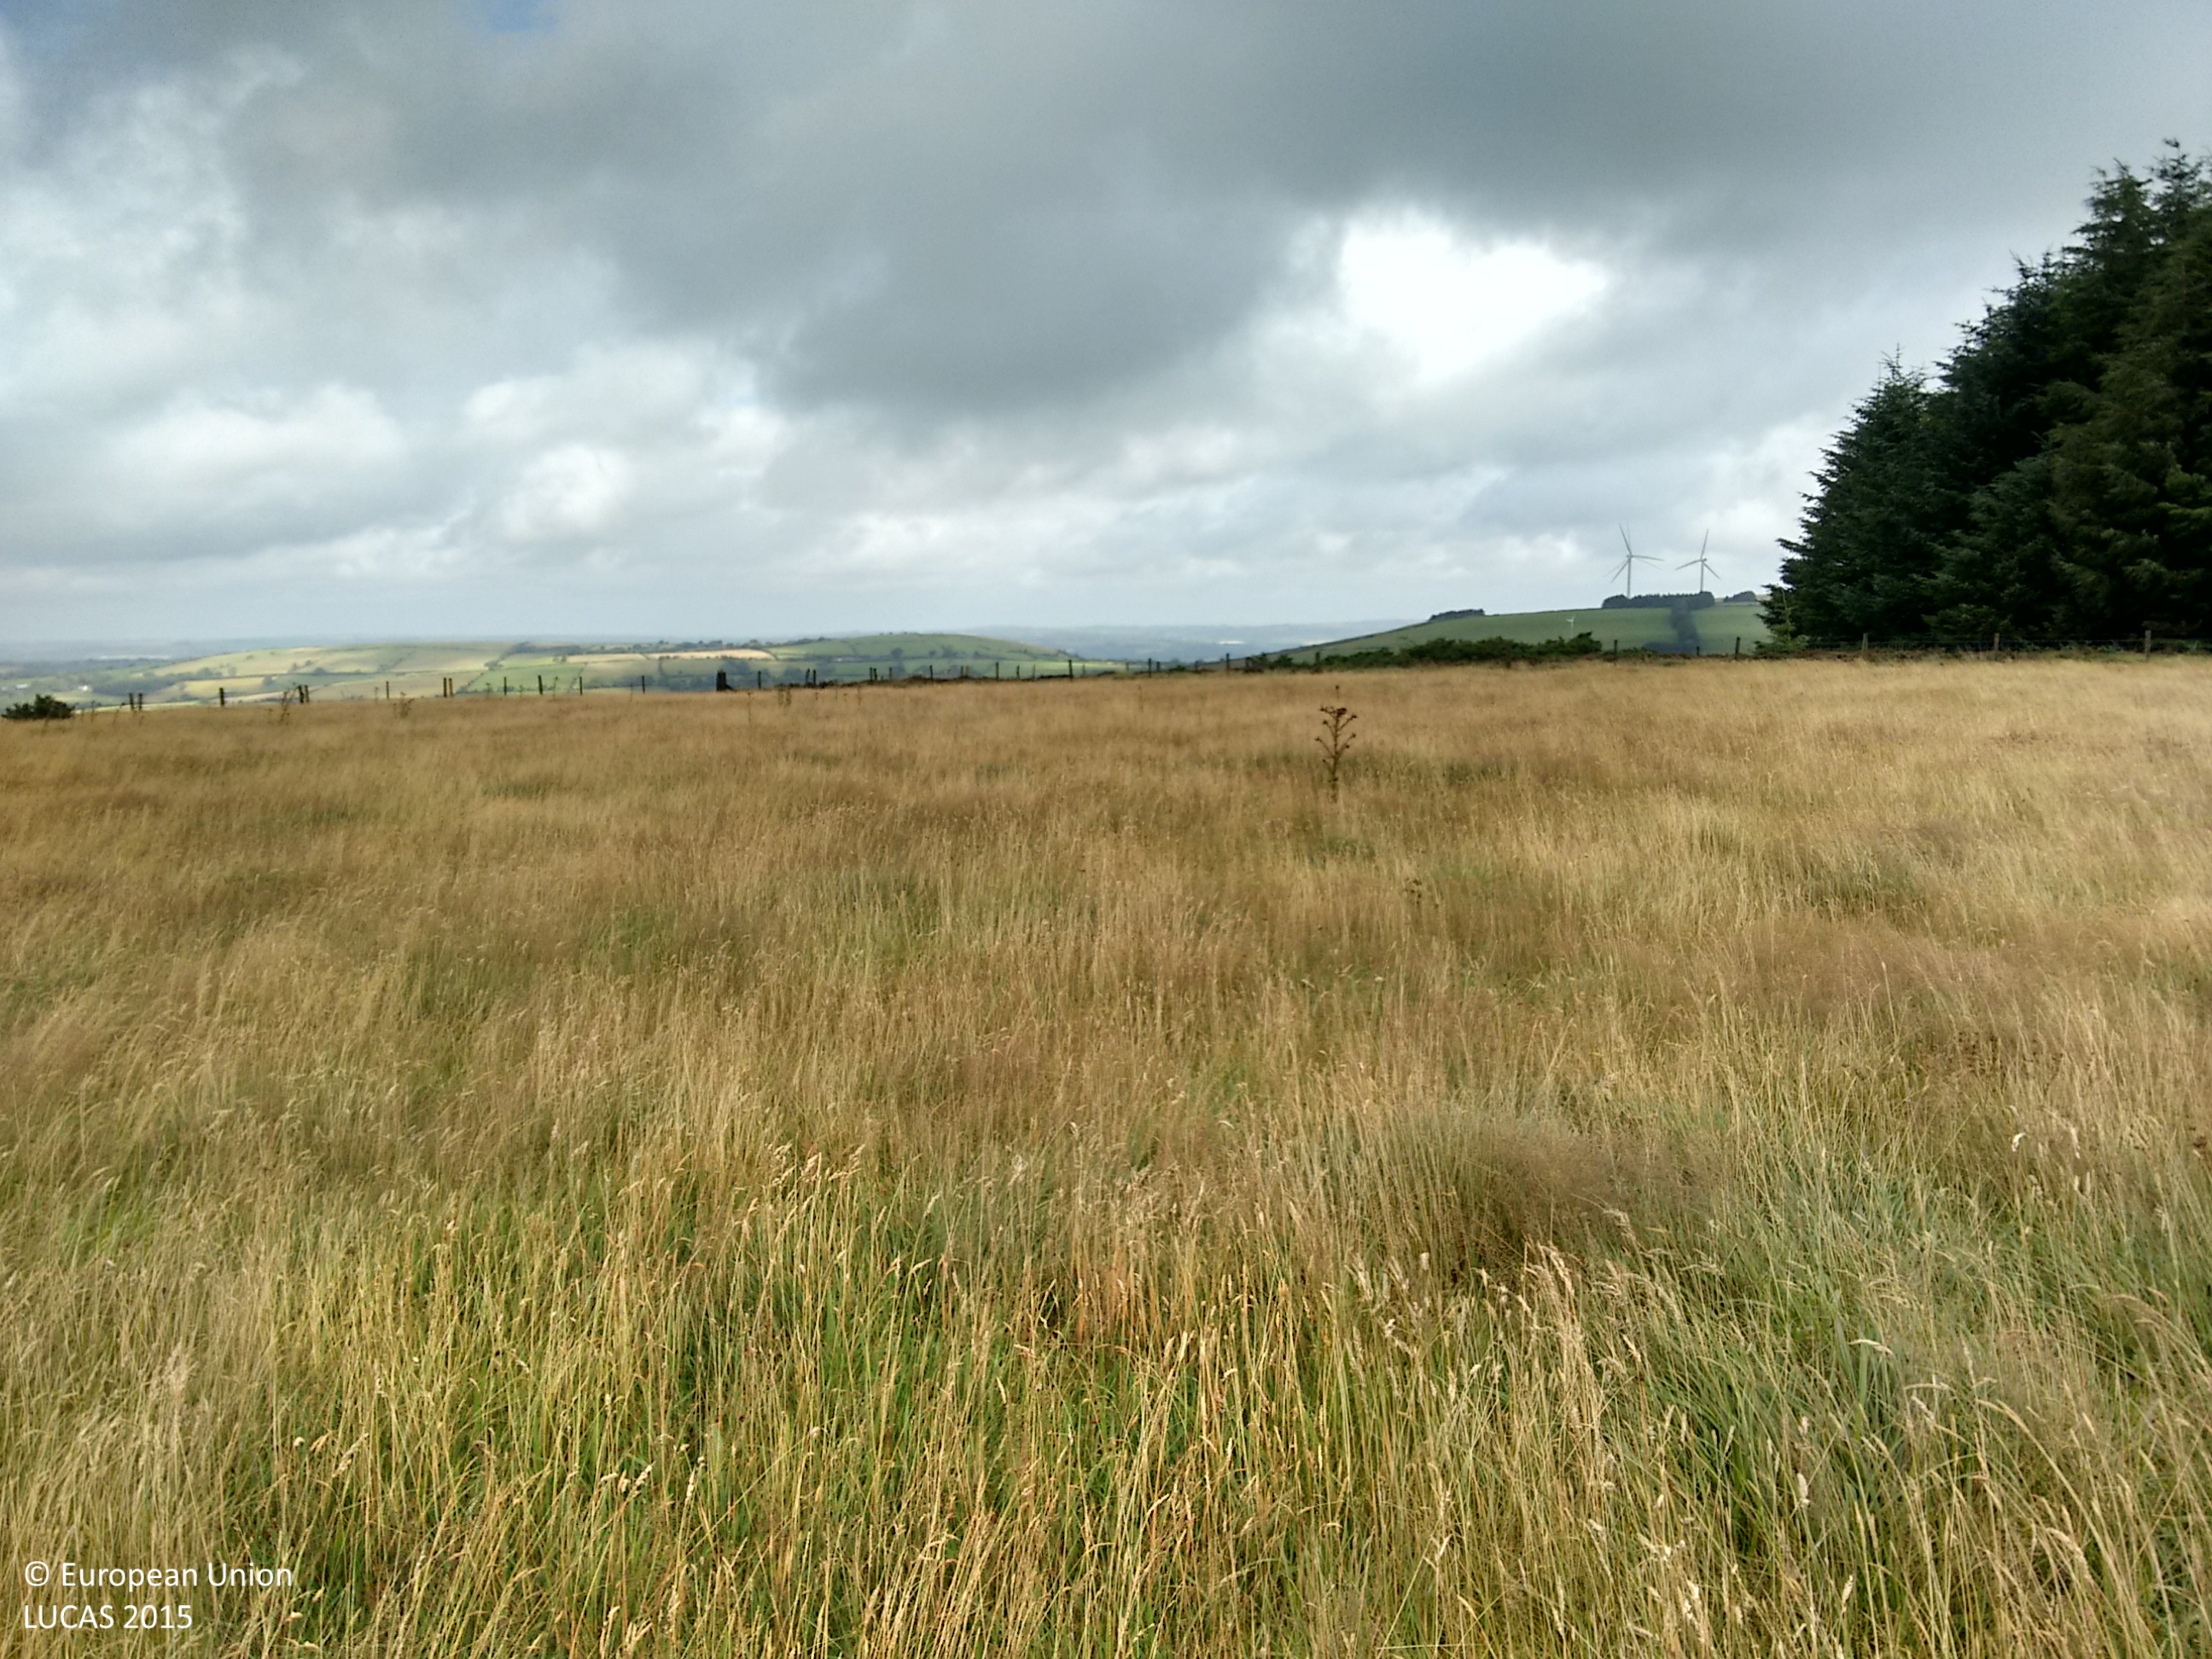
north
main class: Grassland
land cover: Grassland without tree/shrub cover
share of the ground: > 75 %
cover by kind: herbaceous plants 100 %
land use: Agriculture (excluding fallow land and kitchen gardens)
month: August
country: GB
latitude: 51.9810
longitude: -4.4455
